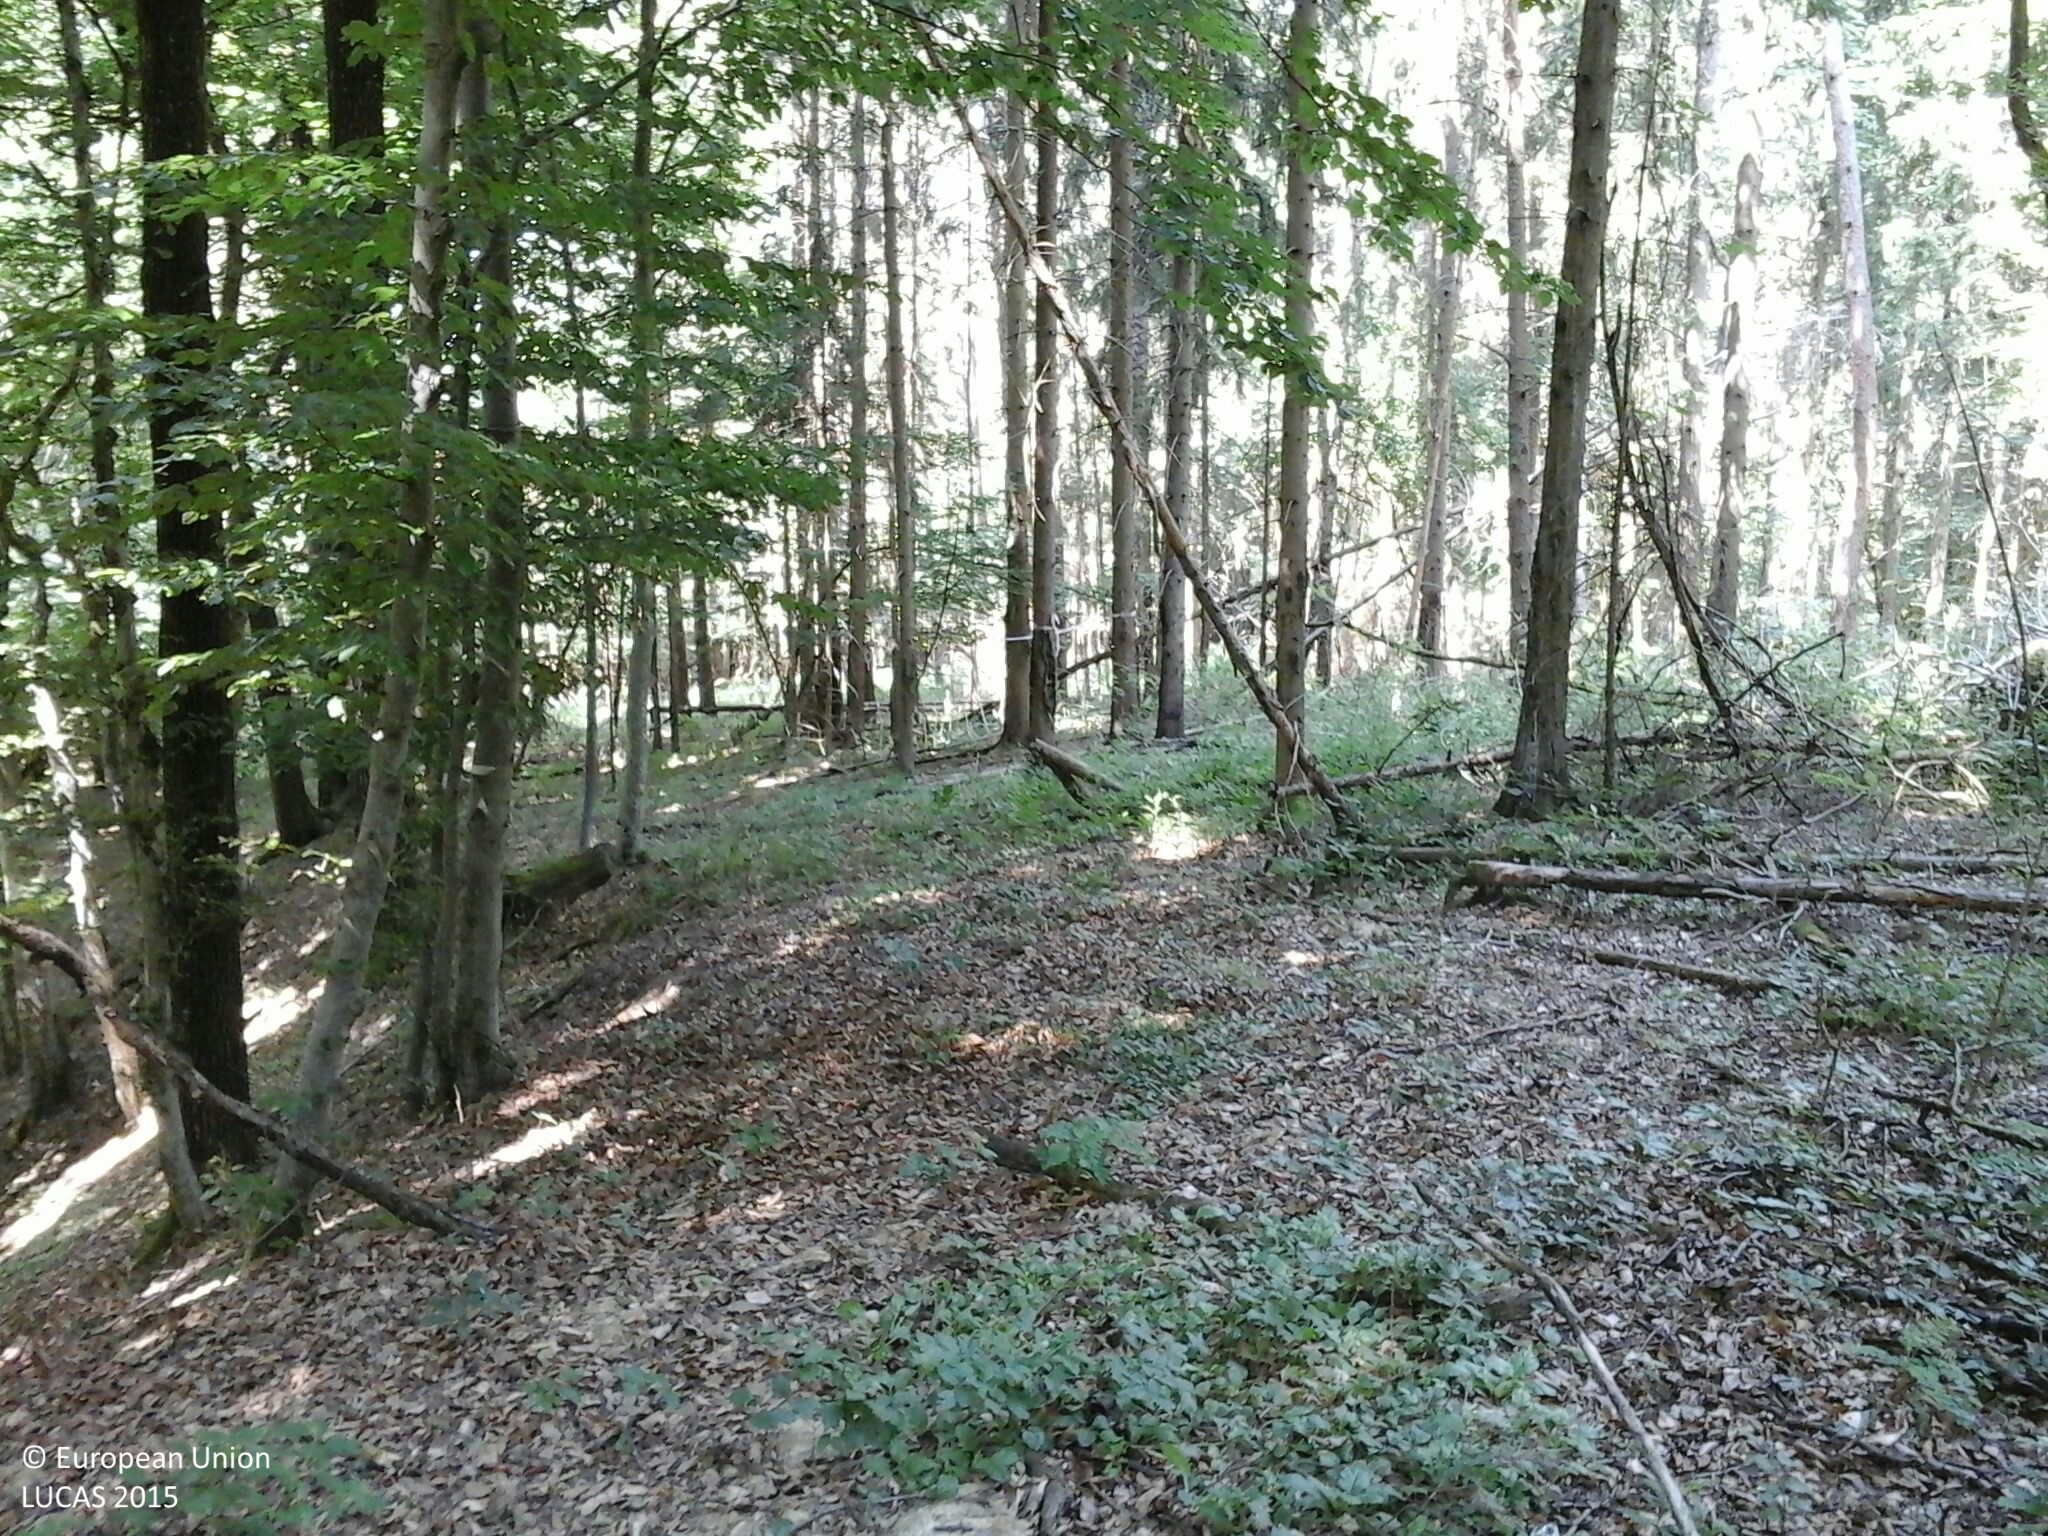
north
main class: Woodland
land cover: Spruce dominated coniferous woodland
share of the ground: > 75 %
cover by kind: coniferous forest trees 90 %, broadleaved forest trees 10 %
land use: Forestry
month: July
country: HU
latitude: 46.9347
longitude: 16.4252
